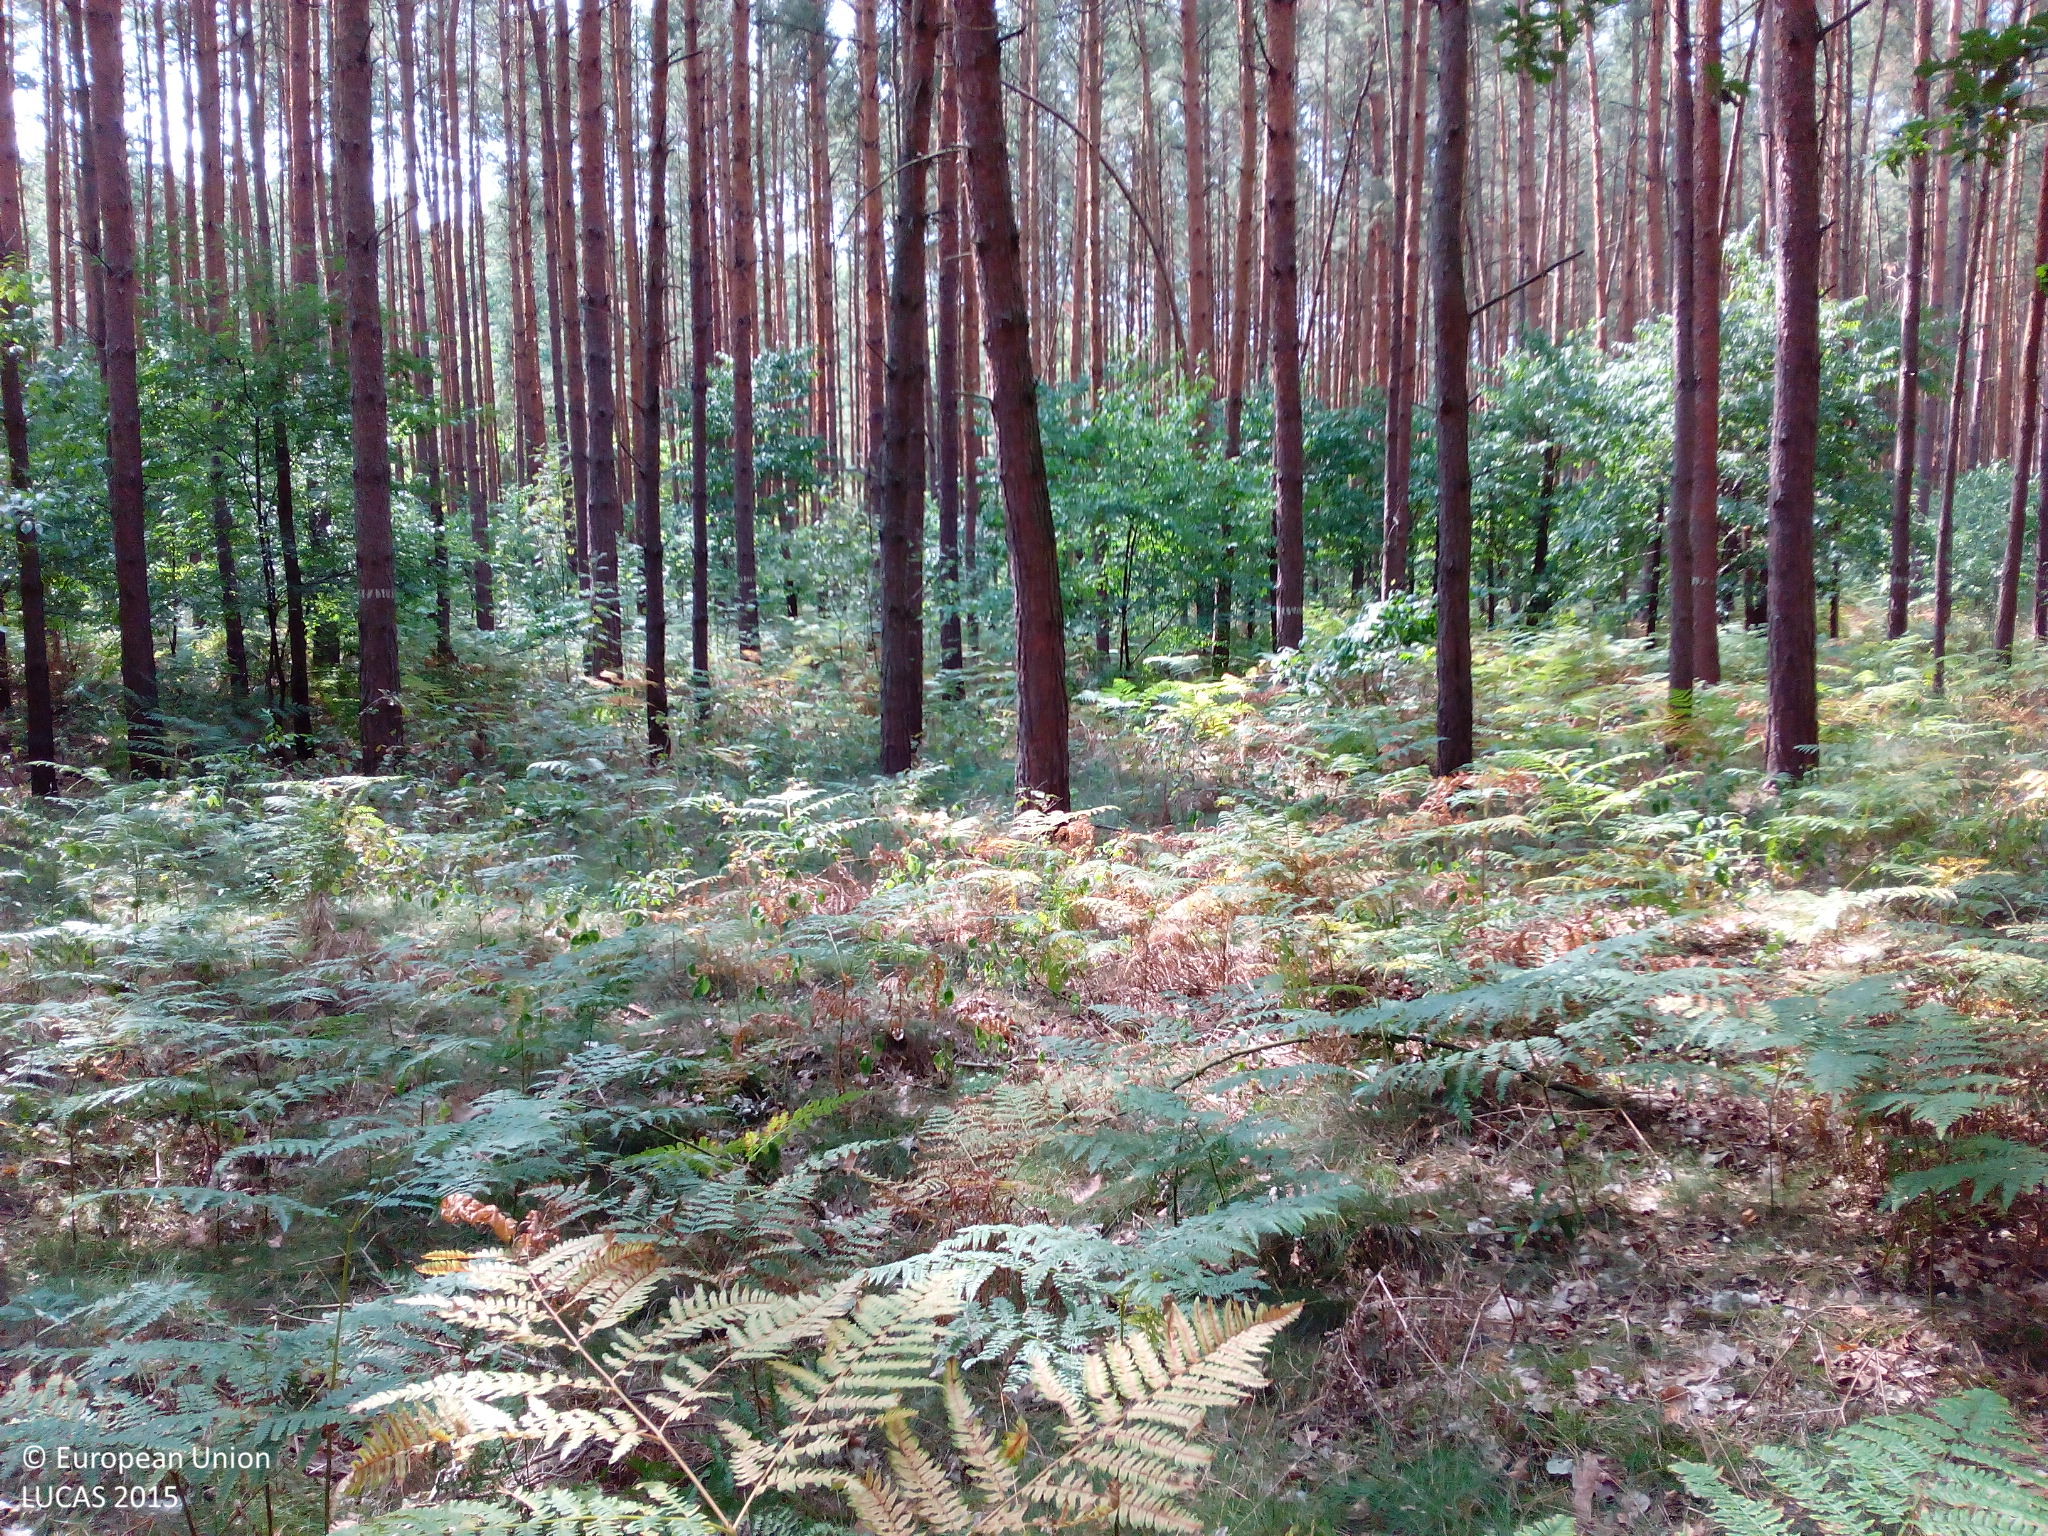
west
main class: Woodland
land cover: Pine dominated coniferous woodland
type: hemiboreal forest and nemoral coniferous forest and mixed broadleaved-coniferous forest
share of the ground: > 75 %
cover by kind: coniferous forest trees 60 %, broadleaved forest trees 20 %, shrubs 10 %, herbaceous plants 5 %, lichens and mosses 5 %
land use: Forestry
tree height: > 5 m
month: August
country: DE
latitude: 52.6408
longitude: 13.1772
